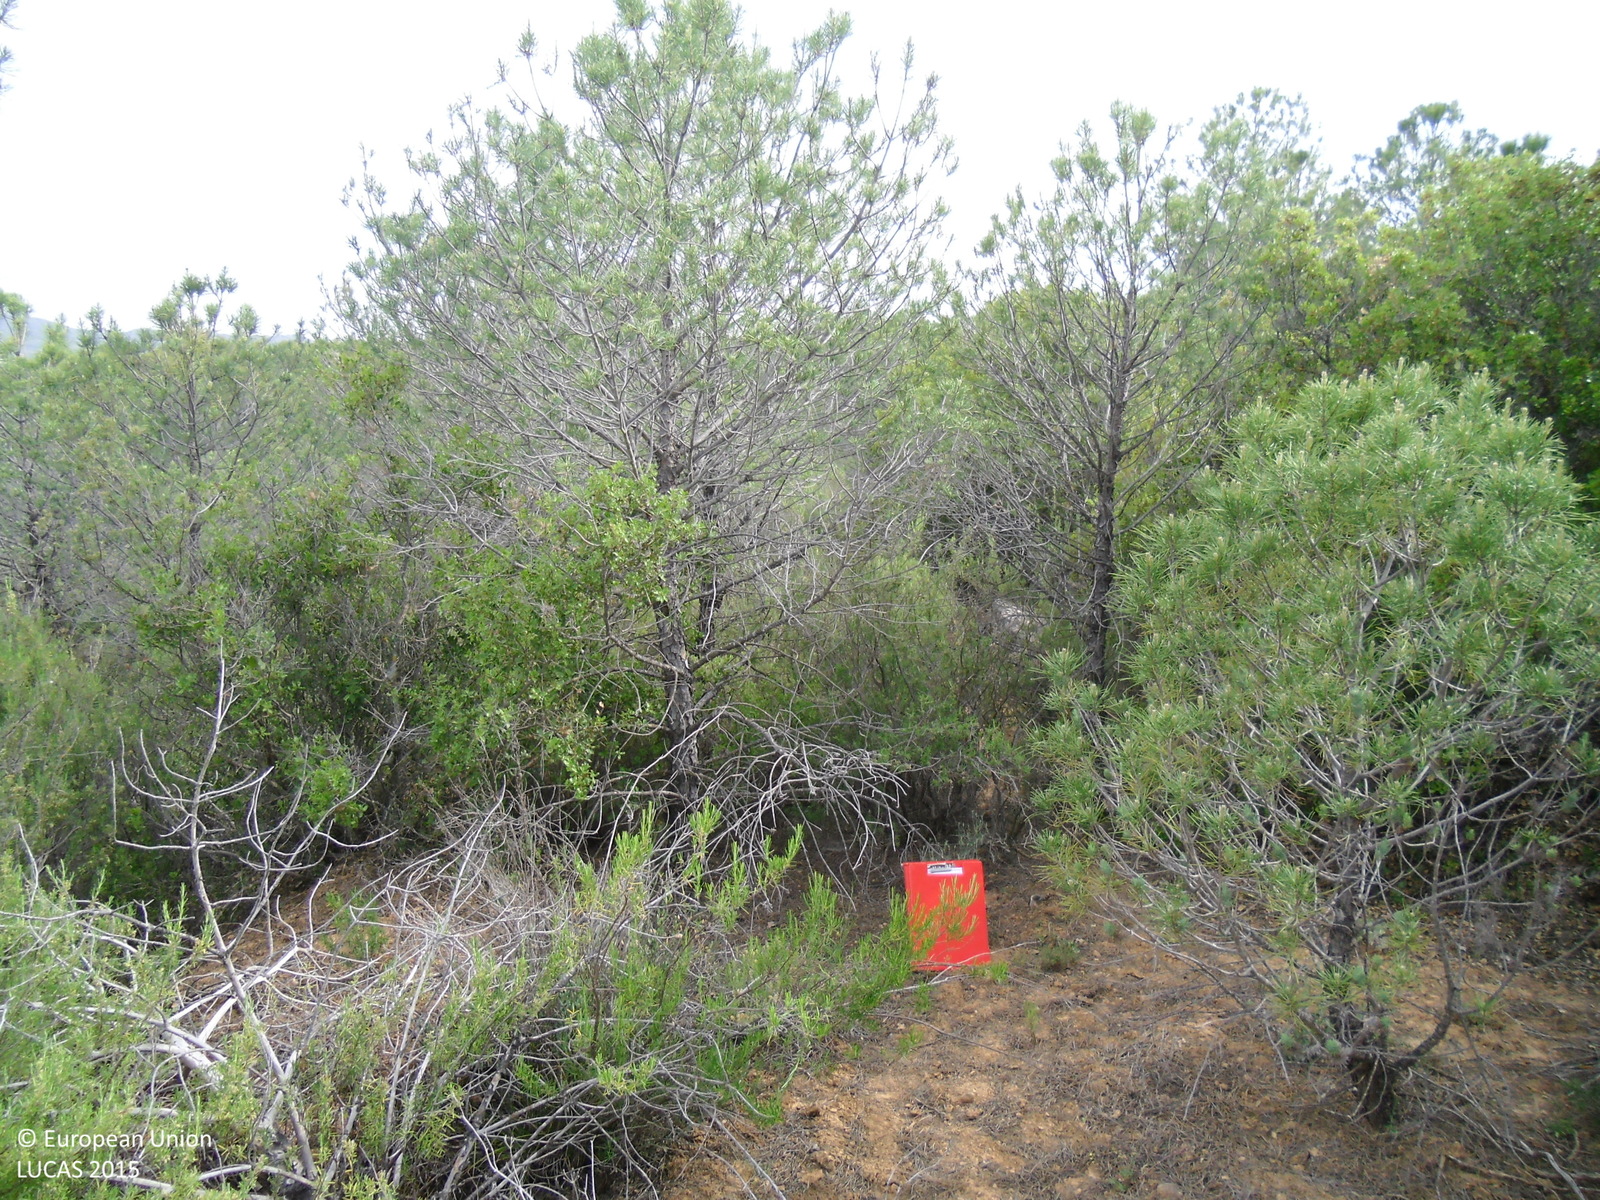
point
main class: Woodland
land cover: Pine dominated coniferous woodland
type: coniferous forest of the mediterranean region
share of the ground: > 75 %
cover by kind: coniferous forest trees 85 %, herbaceous plants 10 %, unconsolidated bare surface 5 %
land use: Forestry
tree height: > 5 m
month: May
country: ES
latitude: 40.3634
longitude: -2.8981
